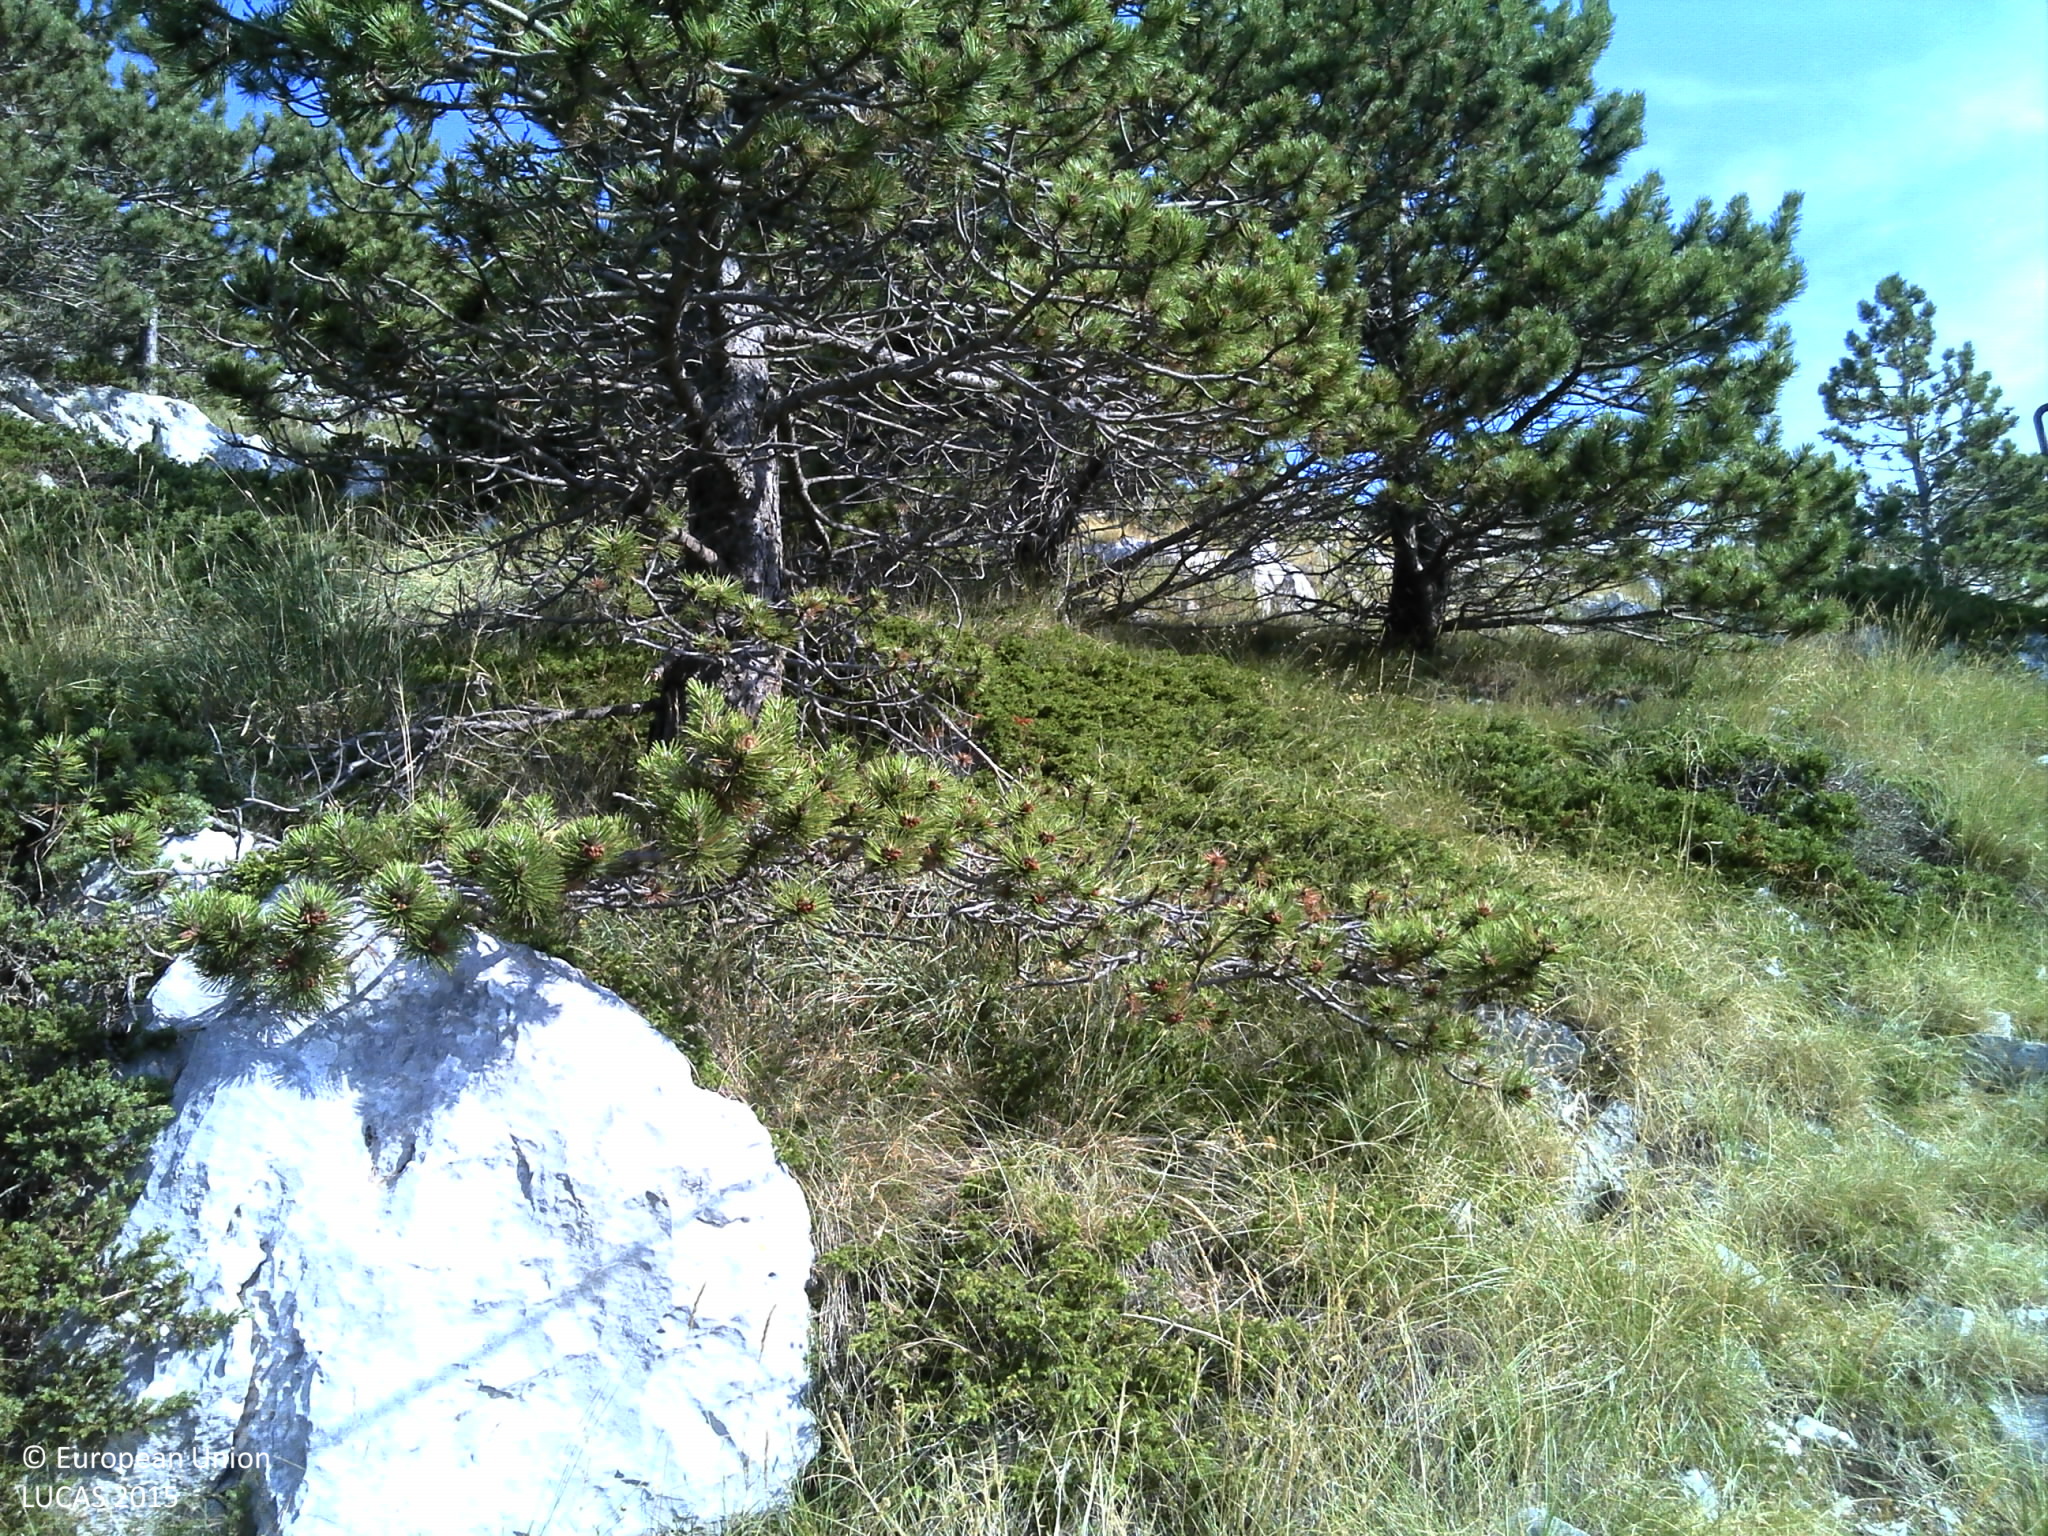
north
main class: Woodland
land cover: Pine dominated coniferous woodland
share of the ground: 10 - 25 %
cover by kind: herbaceous plants 60 %, coniferous forest trees 15 %, shrubs 10 %, unconsolidated bare surface 10 %, consolidated bare surface 5 %
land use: Semi-natural and natural areas not in use
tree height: > 5 m
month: August
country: HR
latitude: 43.2940
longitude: 17.0782
